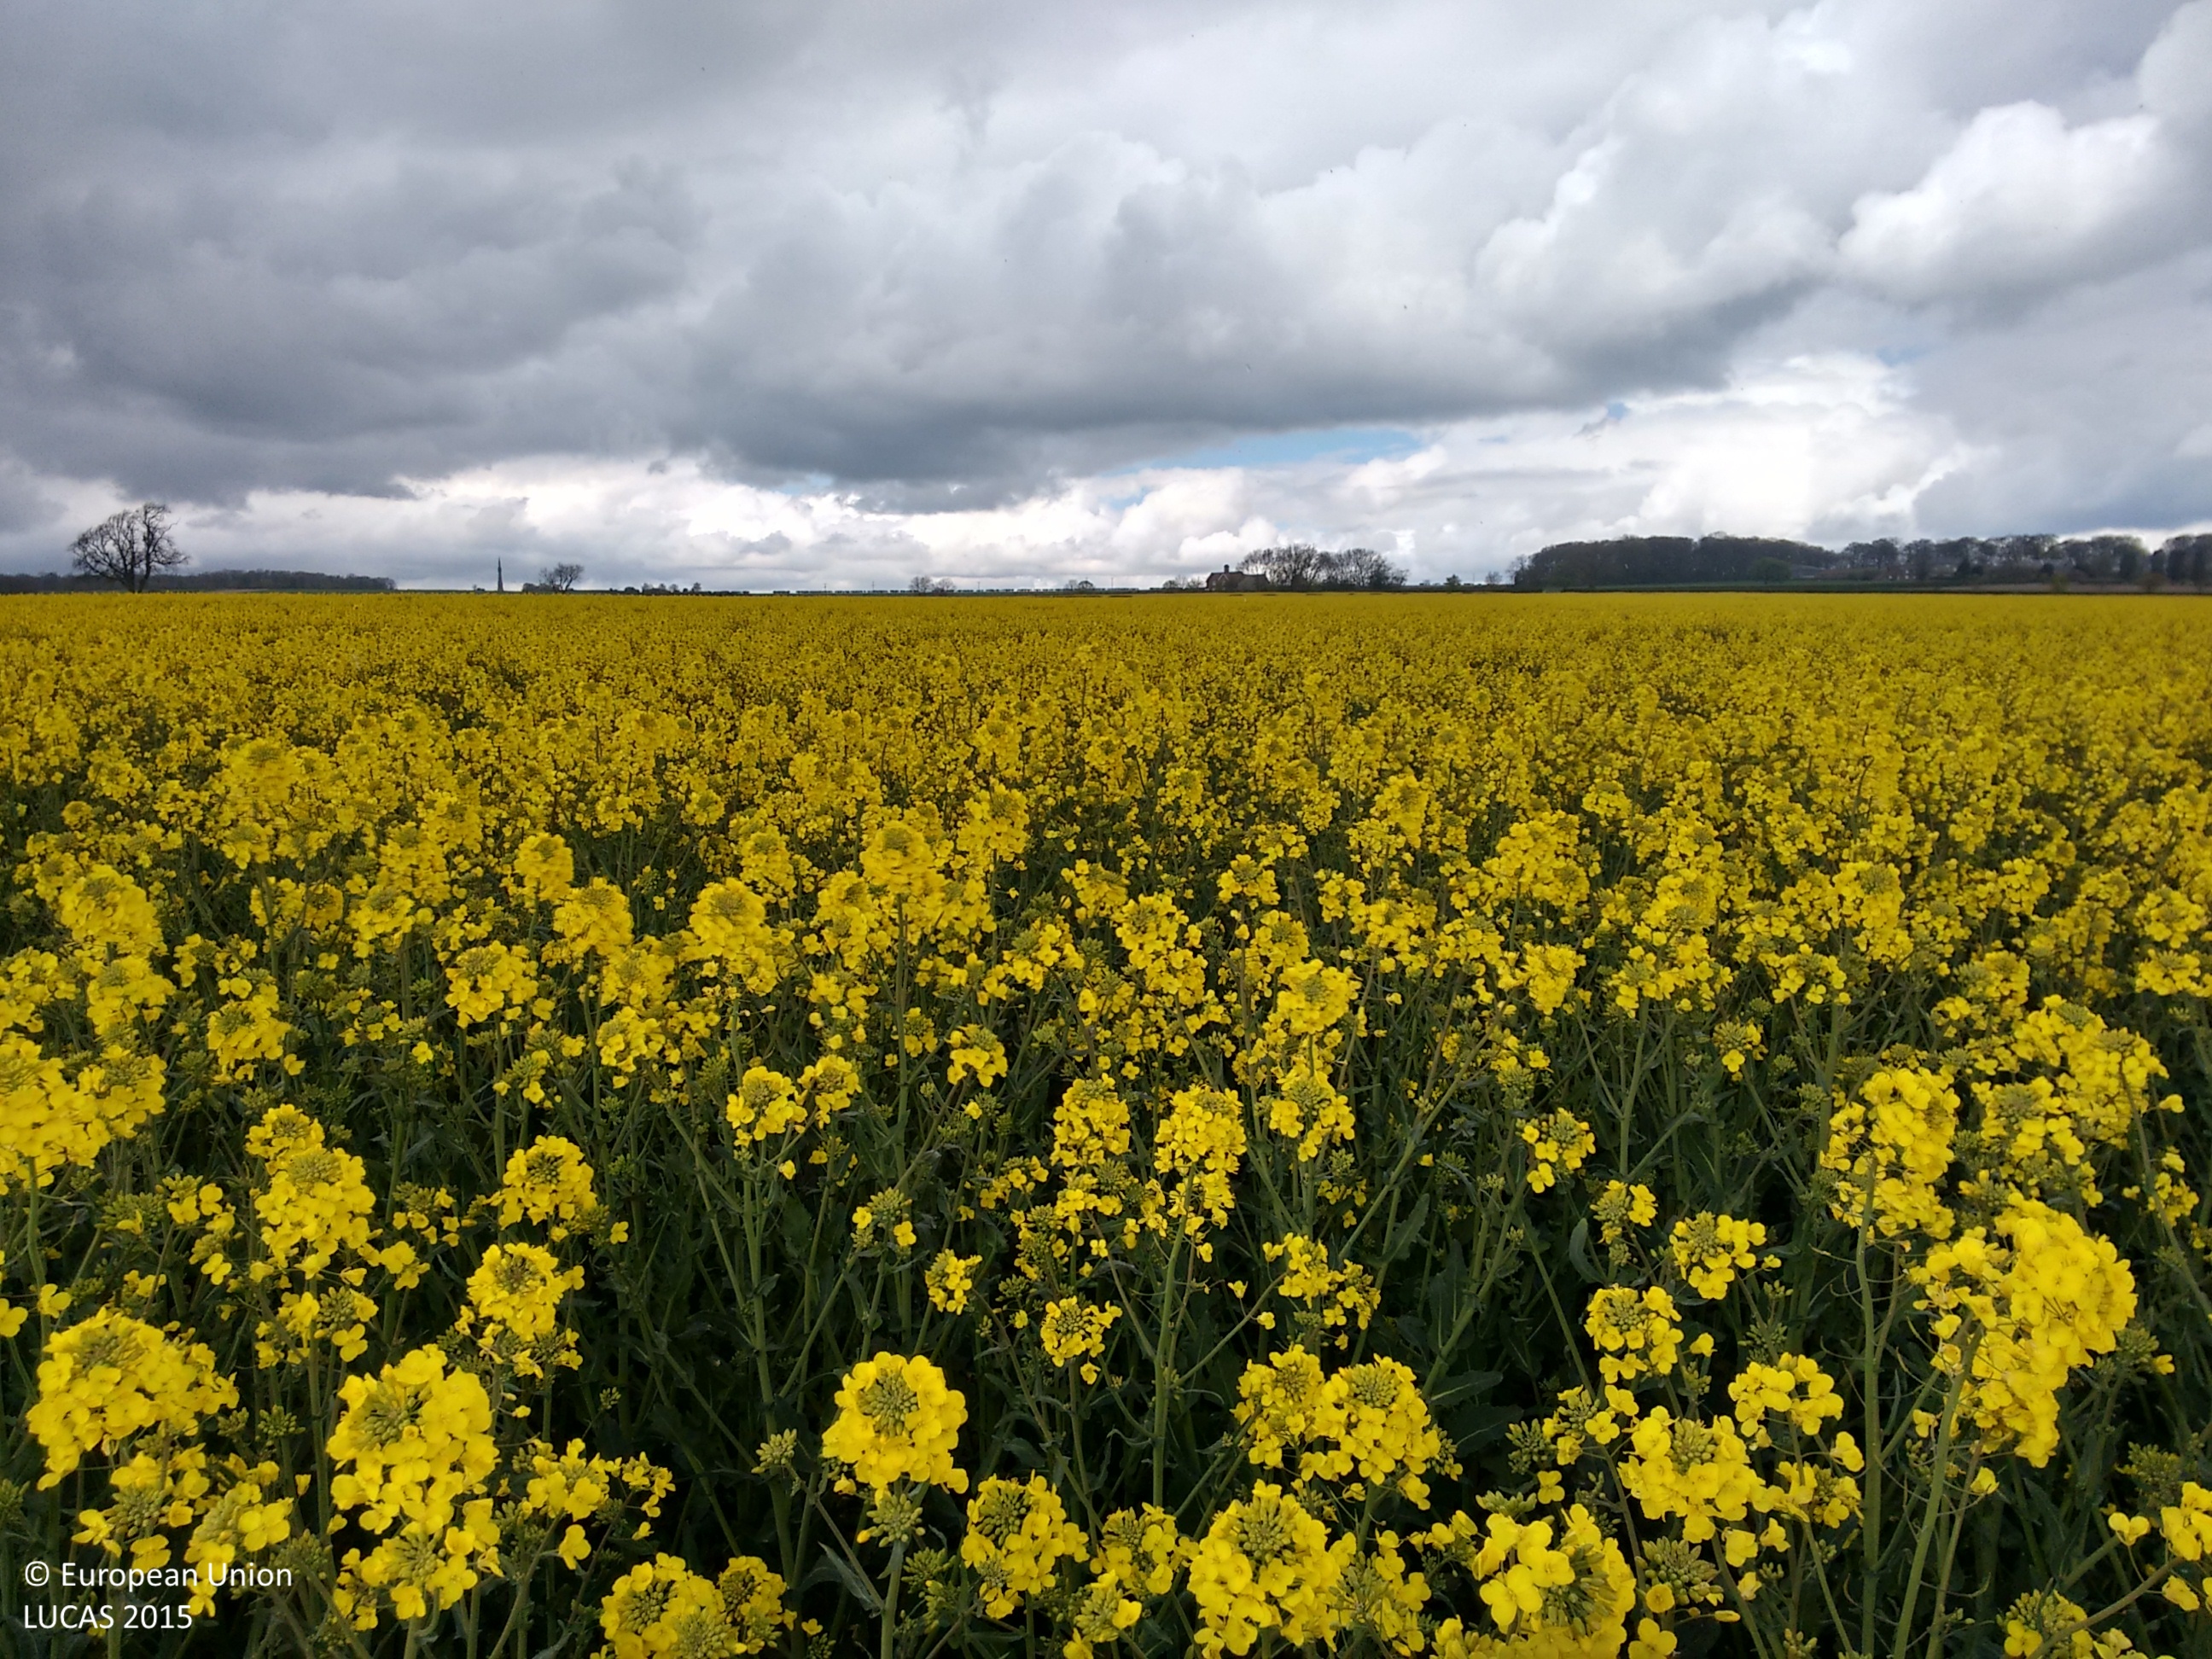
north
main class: Cropland
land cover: Rape and turnip rape
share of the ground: > 75 %
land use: Agriculture (excluding fallow land and kitchen gardens)
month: April
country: GB
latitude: 54.0302
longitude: -0.5250
